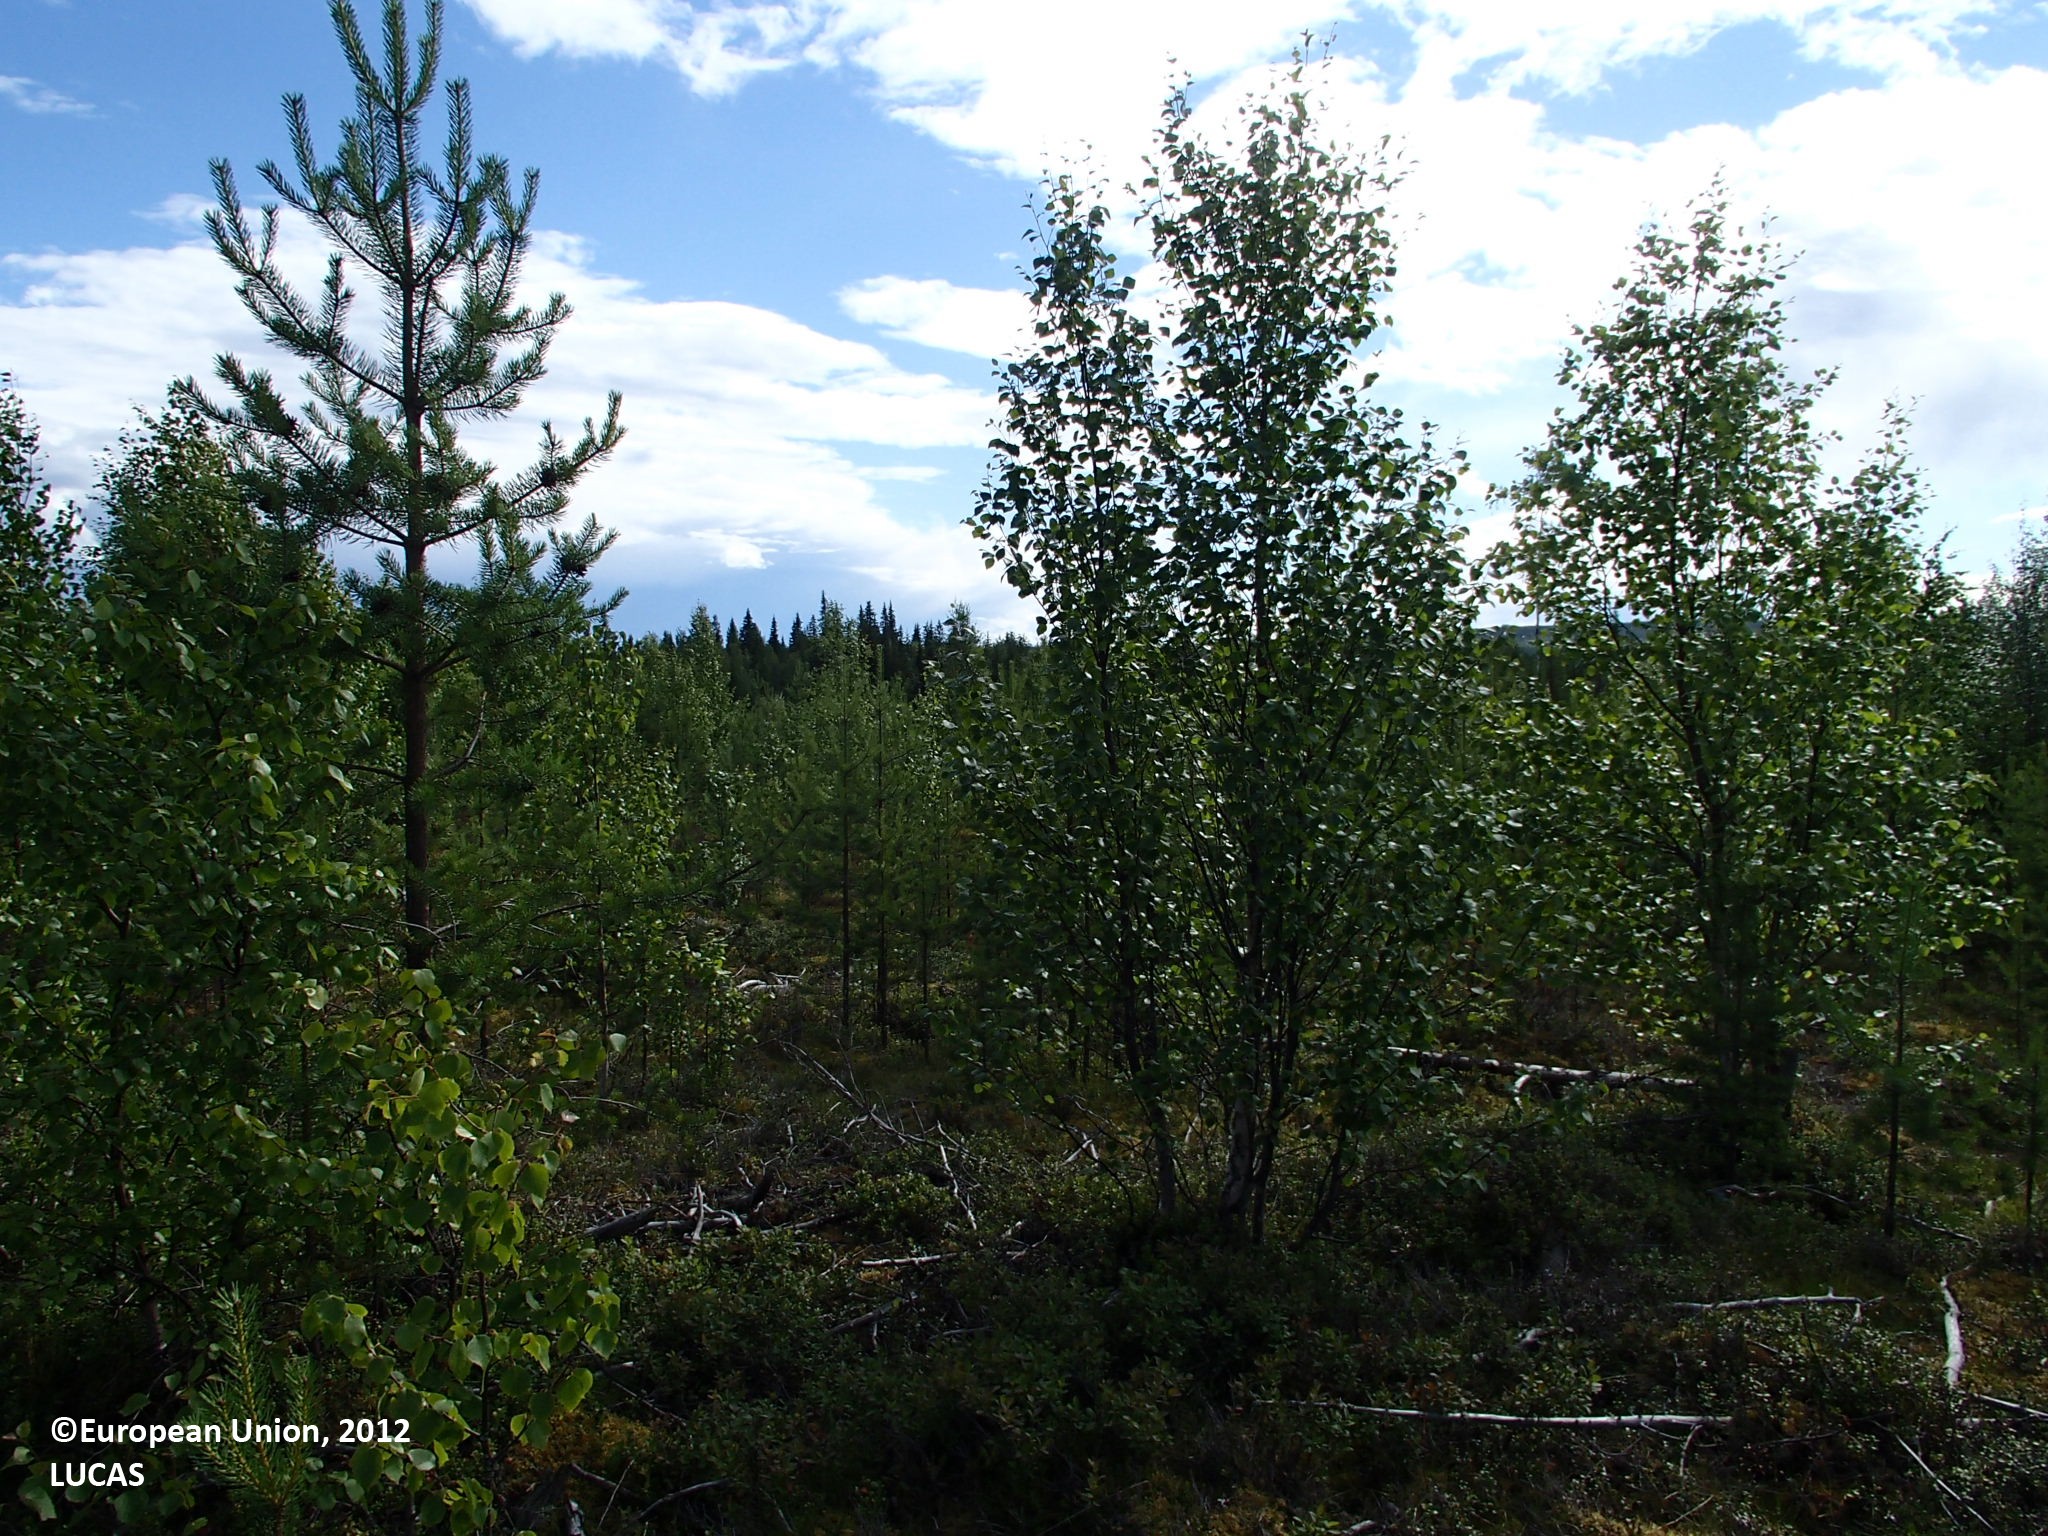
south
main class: Woodland
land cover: Other mixed woodland
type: boreal forest
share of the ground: 25 - 50 %
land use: Forestry
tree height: < 5 m
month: July
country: FI
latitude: 66.6417
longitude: 25.3608
